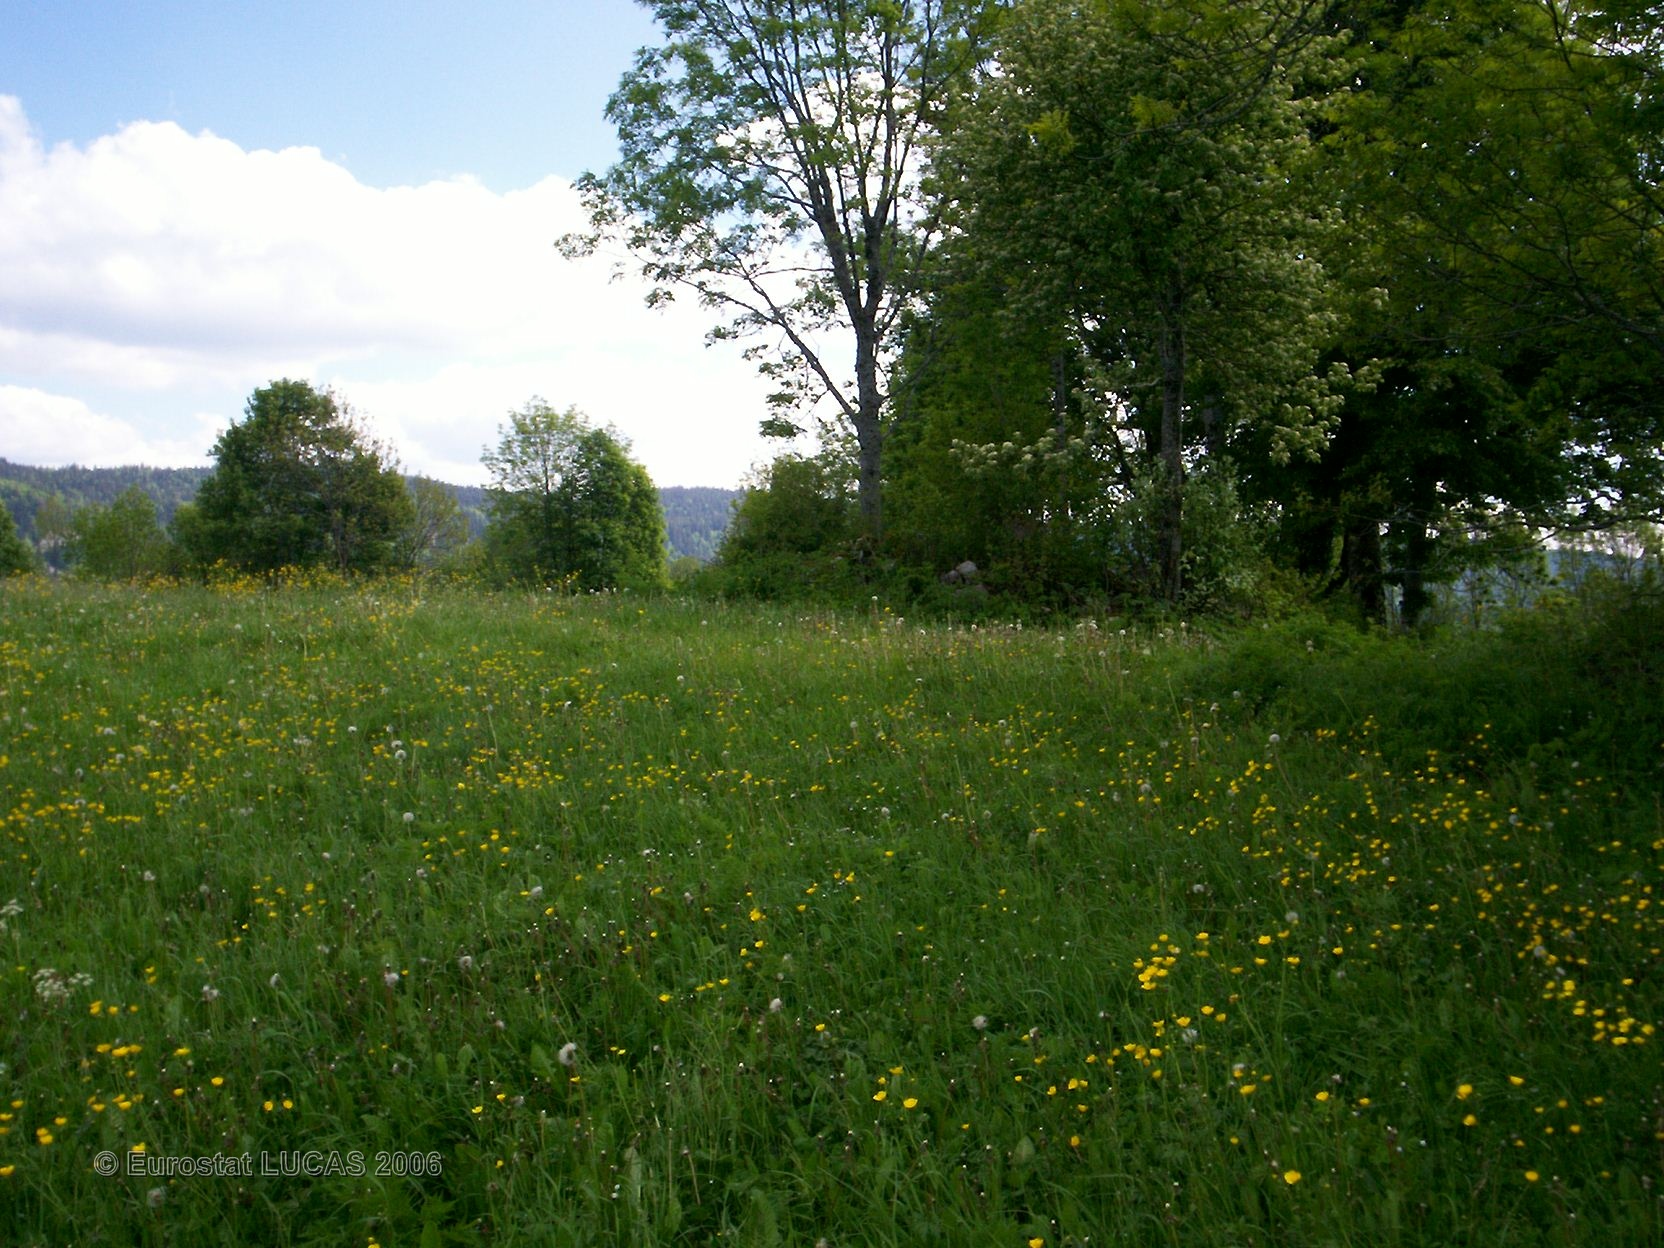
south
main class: Grassland
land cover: Grassland without tree/shrub cover
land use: Agriculture (excluding fallow land and kitchen gardens)
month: June
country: FR
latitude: 46.7305
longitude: 6.0900
